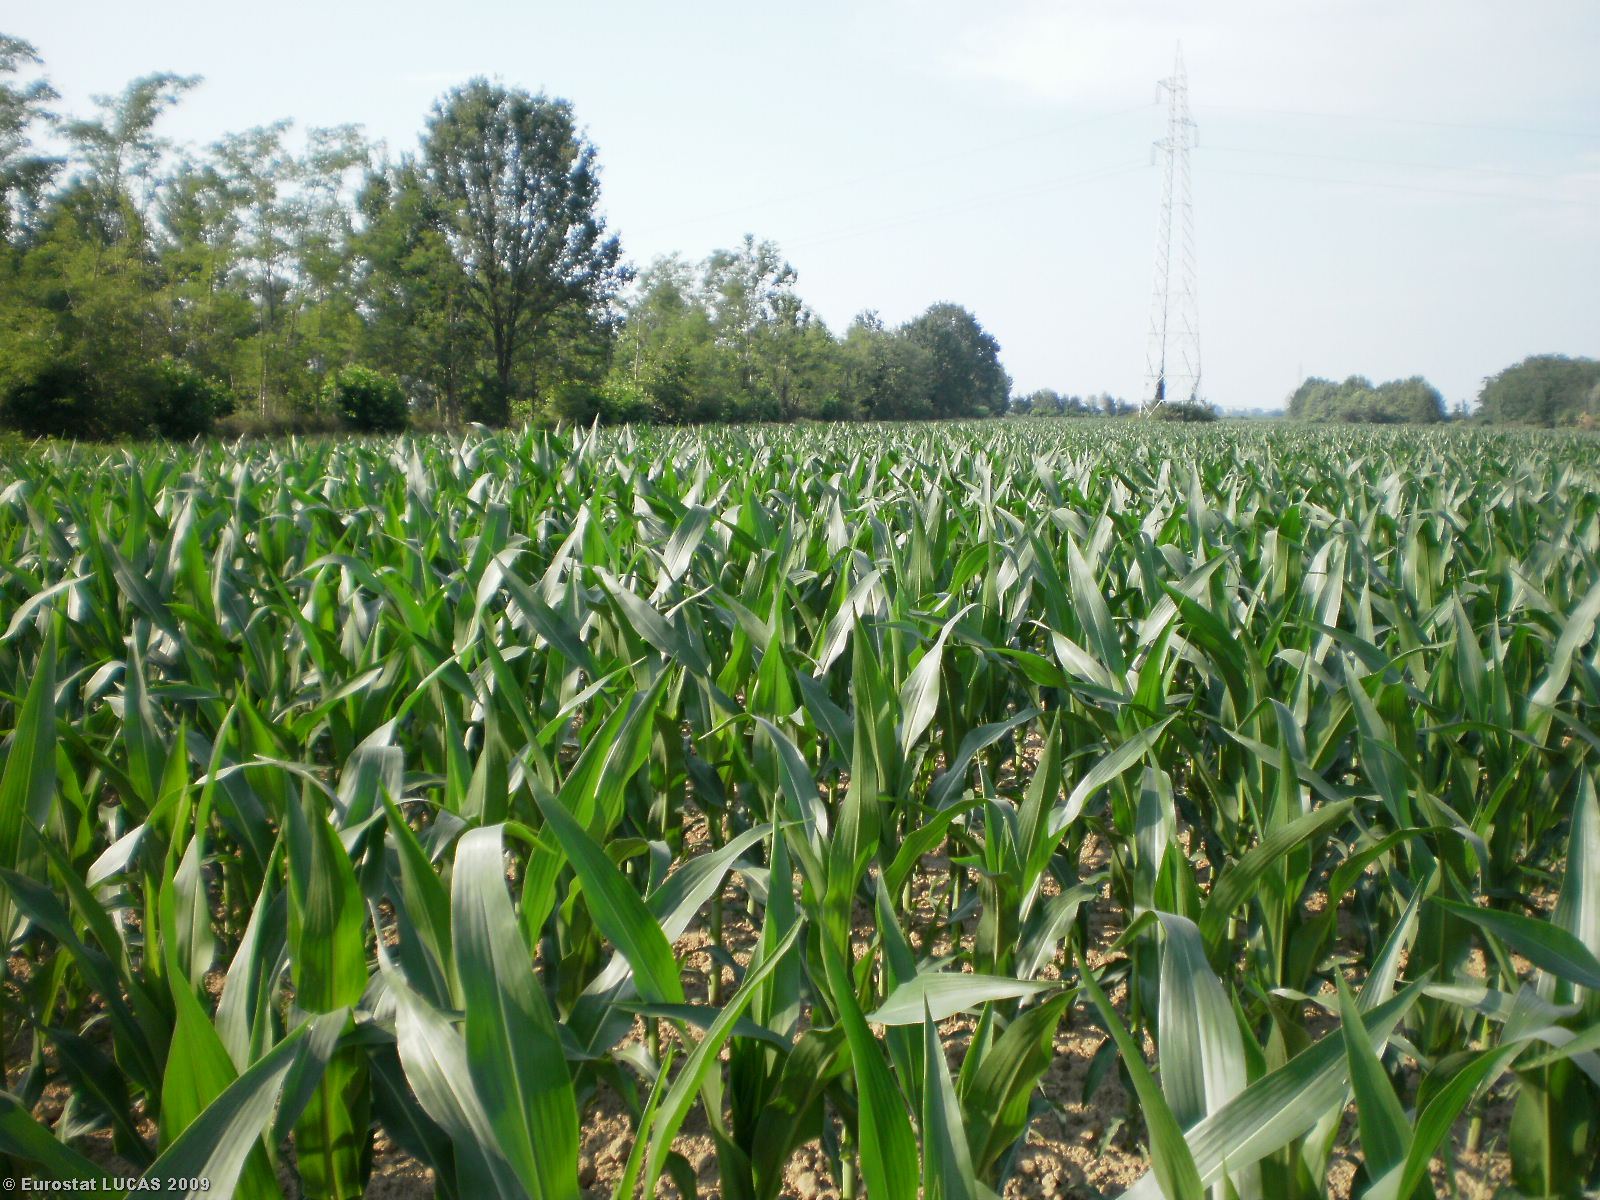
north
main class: Cropland
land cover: Maize
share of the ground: > 75 %
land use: Agriculture (excluding fallow land and kitchen gardens)
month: June
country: IT
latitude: 45.1800
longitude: 10.0381
